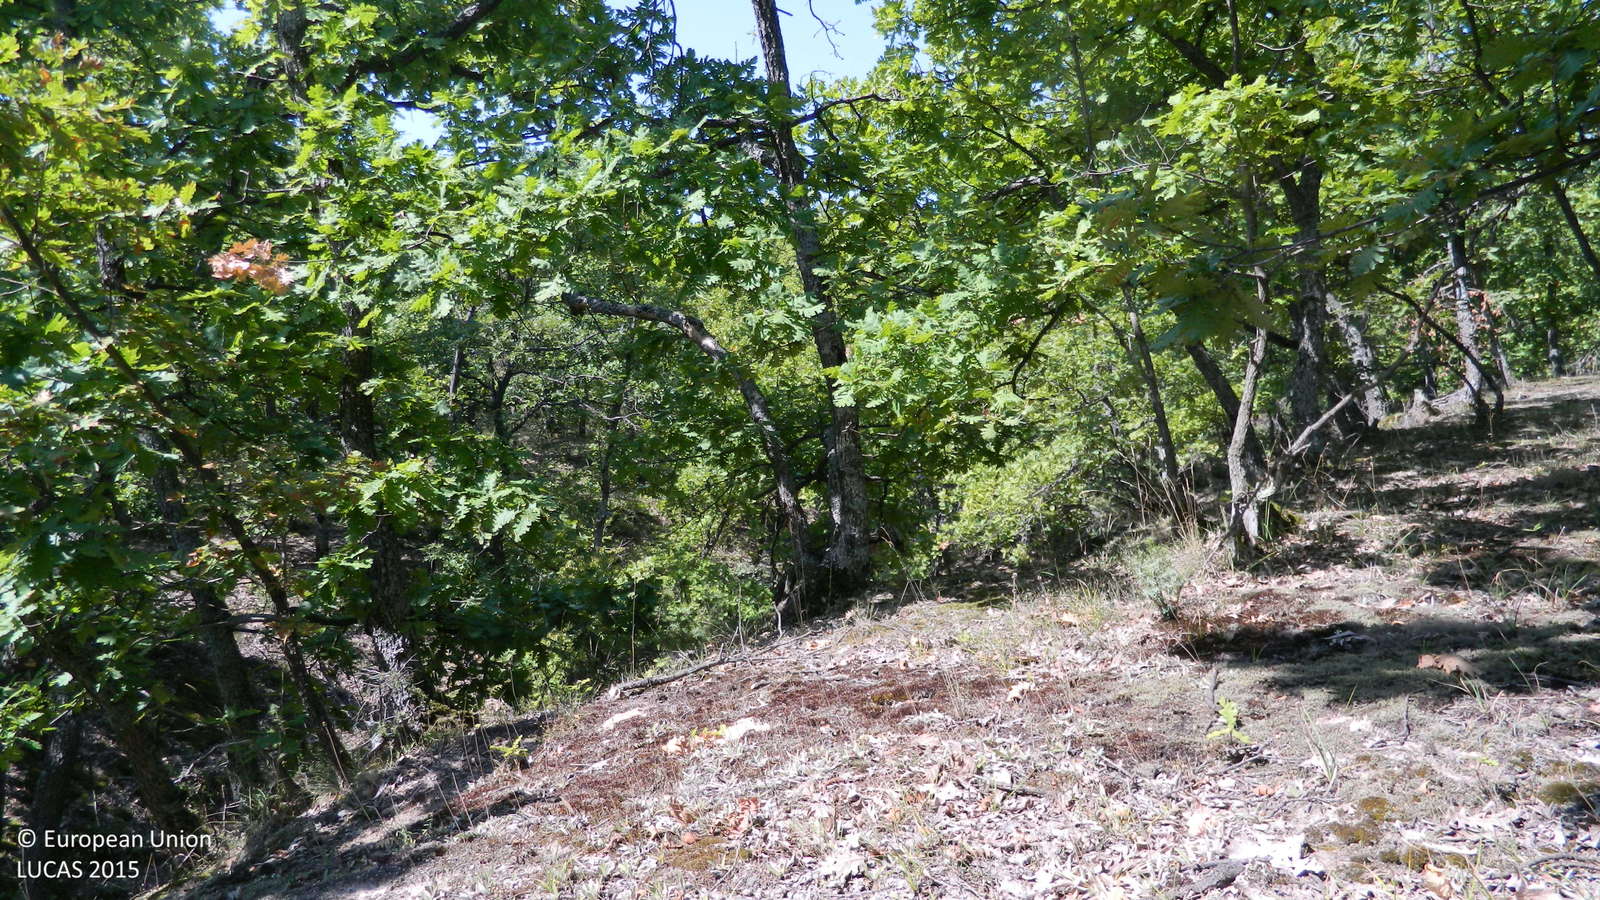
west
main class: Woodland
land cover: Broadleaved woodland
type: thermophilous deciduous forest
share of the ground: > 75 %
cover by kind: broadleaved forest trees 85 %, herbaceous plants 10 %, unconsolidated bare surface 5 %
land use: Forestry
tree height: > 5 m
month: September
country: BG
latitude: 41.6829
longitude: 25.6686
